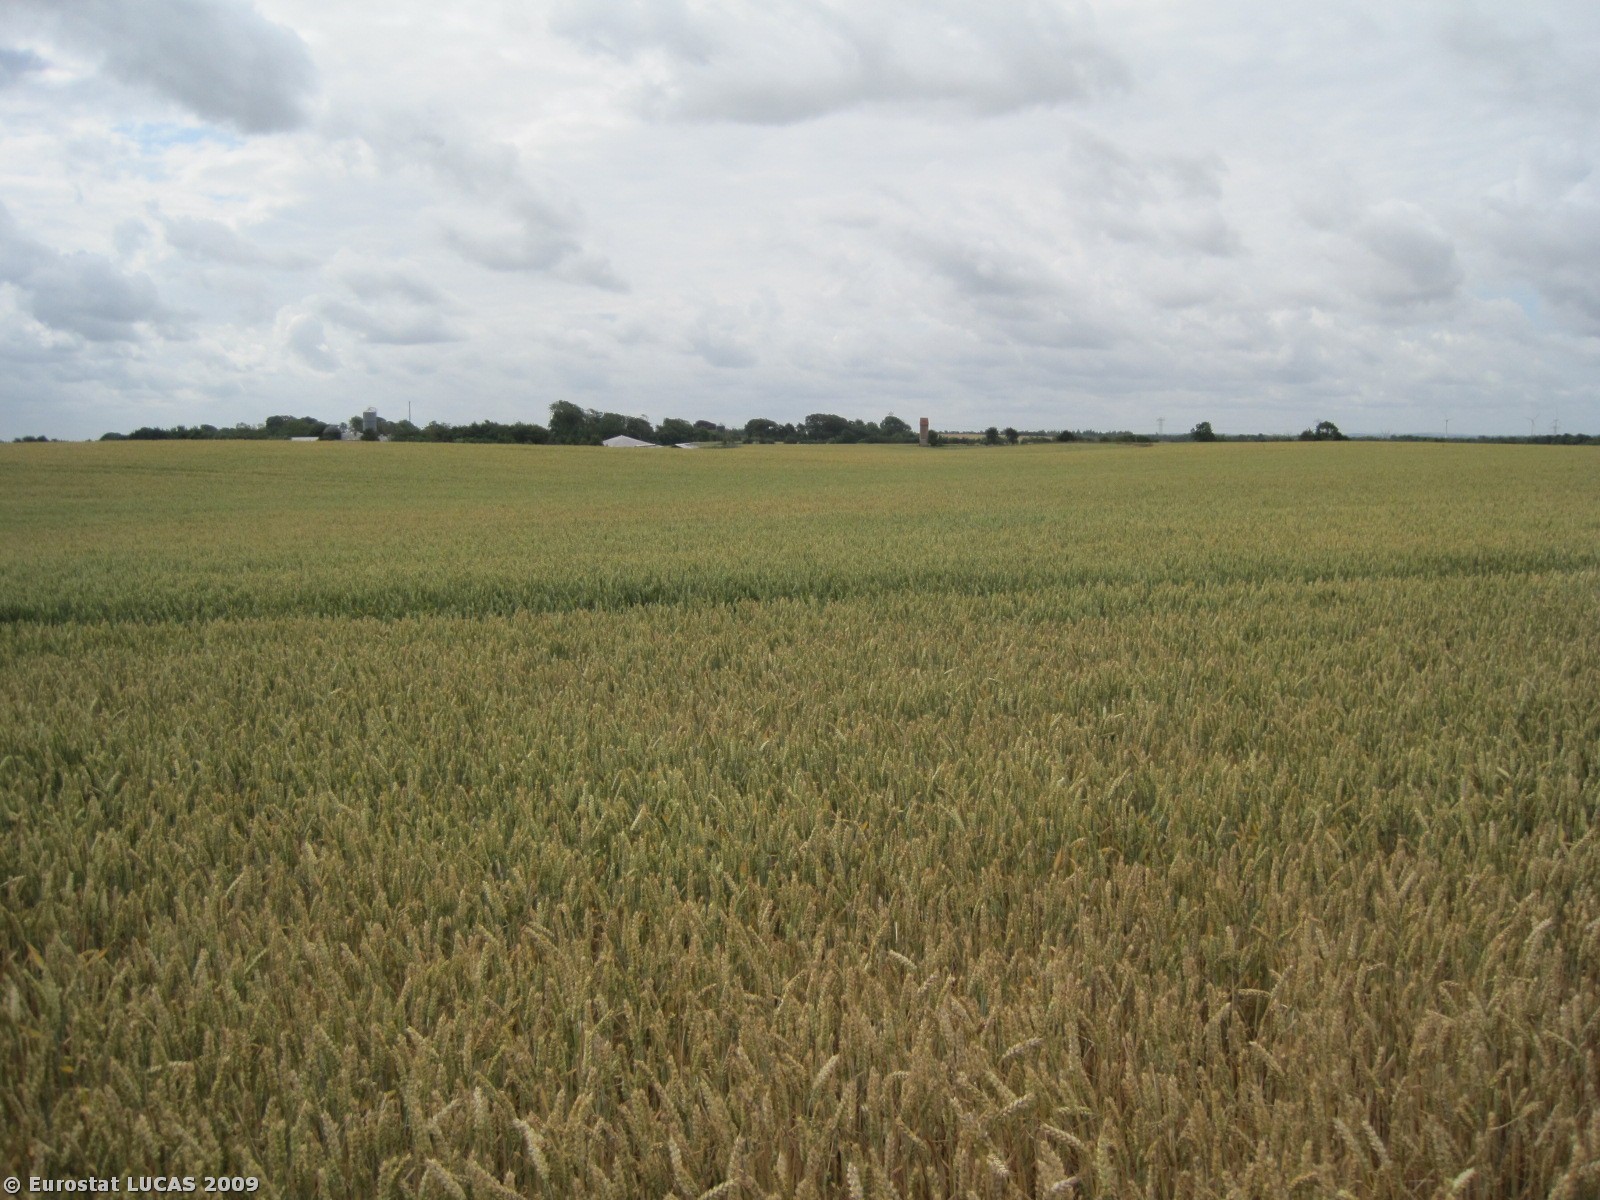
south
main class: Cropland
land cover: Common wheat
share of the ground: > 75 %
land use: Agriculture (excluding fallow land and kitchen gardens)
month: July
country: DK
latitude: 56.4157
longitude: 8.7858
